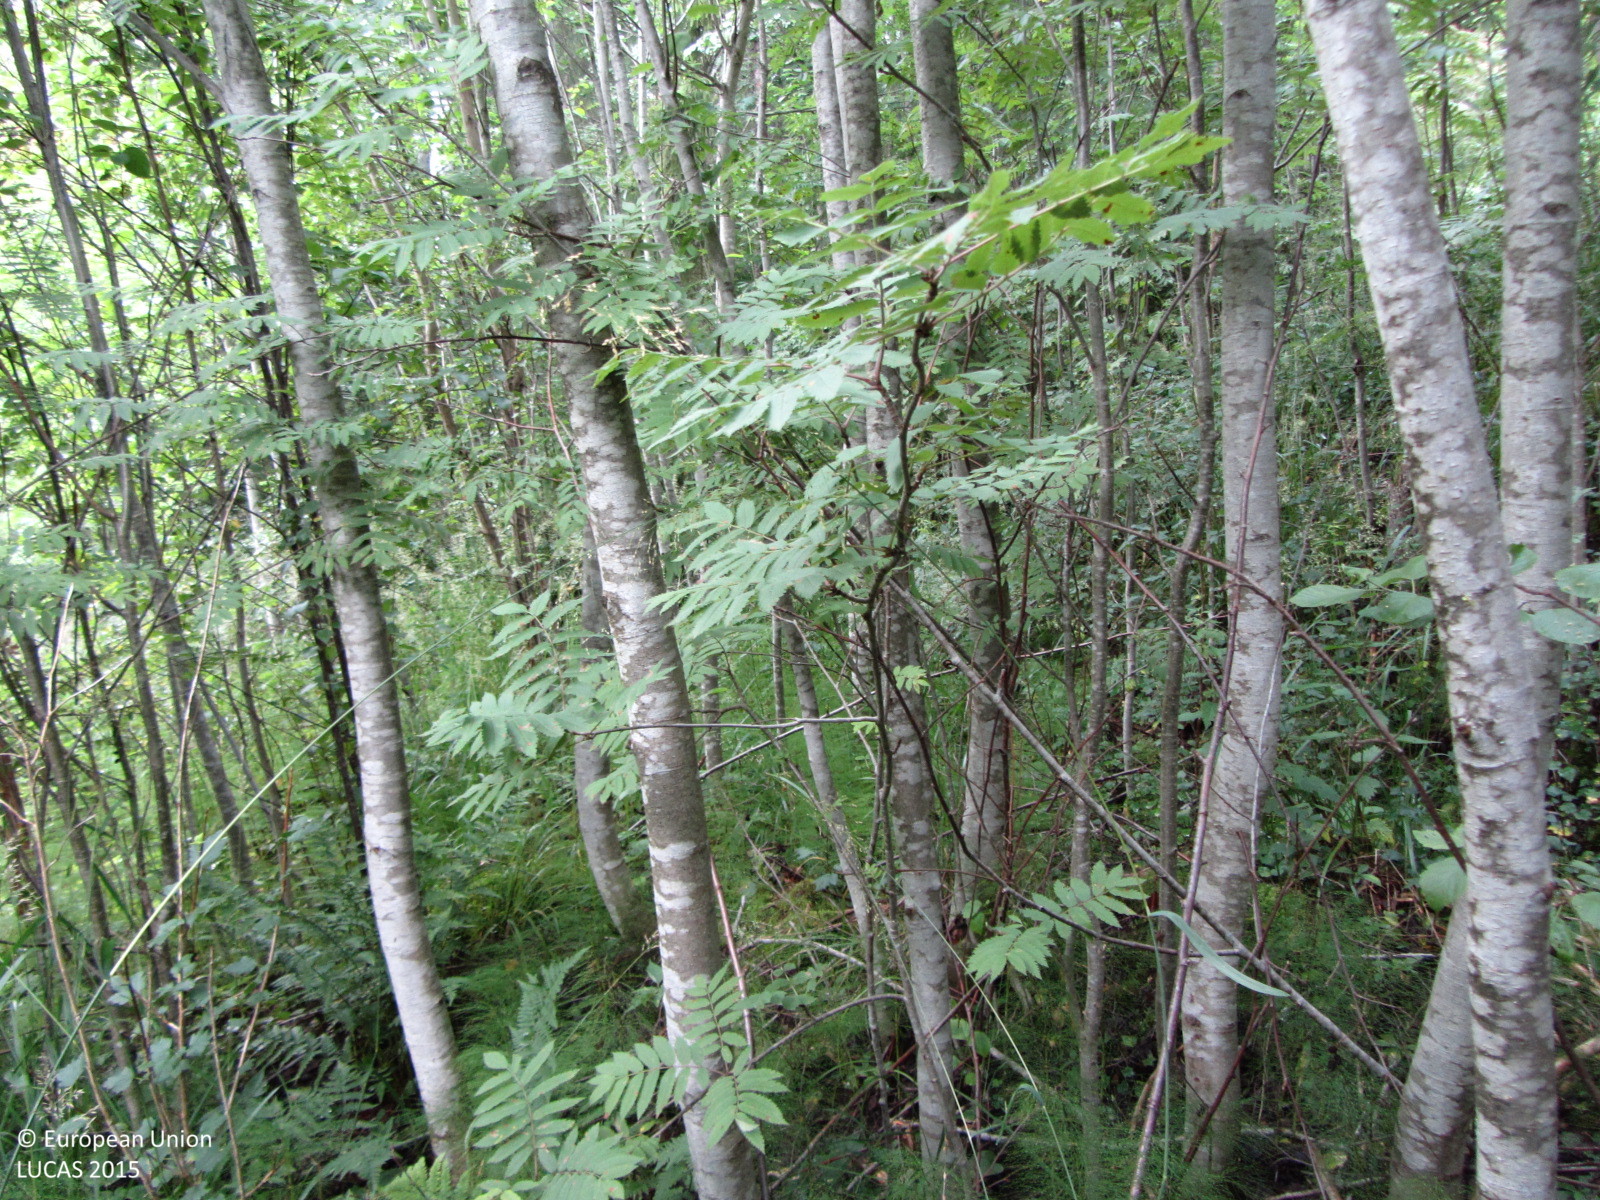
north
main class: Woodland
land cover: Broadleaved woodland
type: boreal forest
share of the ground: > 75 %
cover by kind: broadleaved forest trees 85 %, herbaceous plants 10 %, coniferous forest trees 5 %
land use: Forestry
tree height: > 5 m
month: July
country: FI
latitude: 60.4730
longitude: 24.3092
